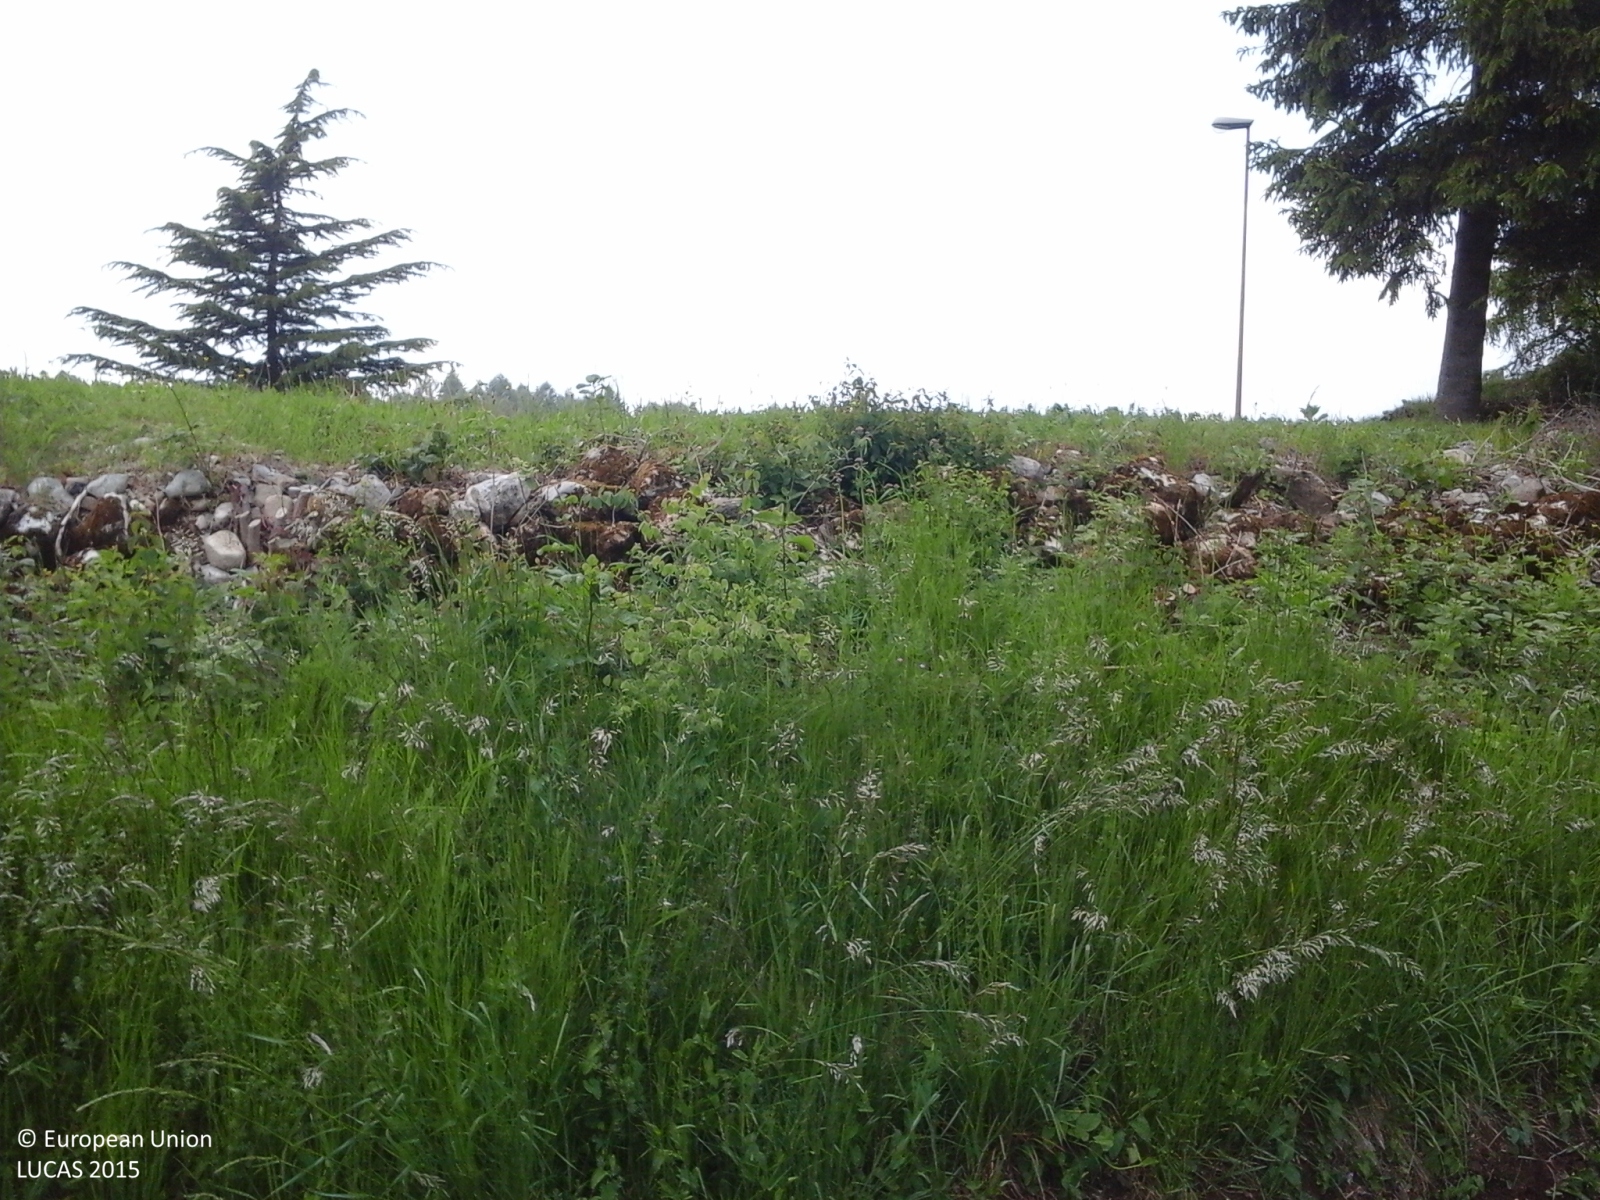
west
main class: Cropland
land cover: Other fresh vegetables
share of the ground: < 10 %
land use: Agriculture (excluding fallow land and kitchen gardens)
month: June
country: IT
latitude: 45.8967
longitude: 10.9394
